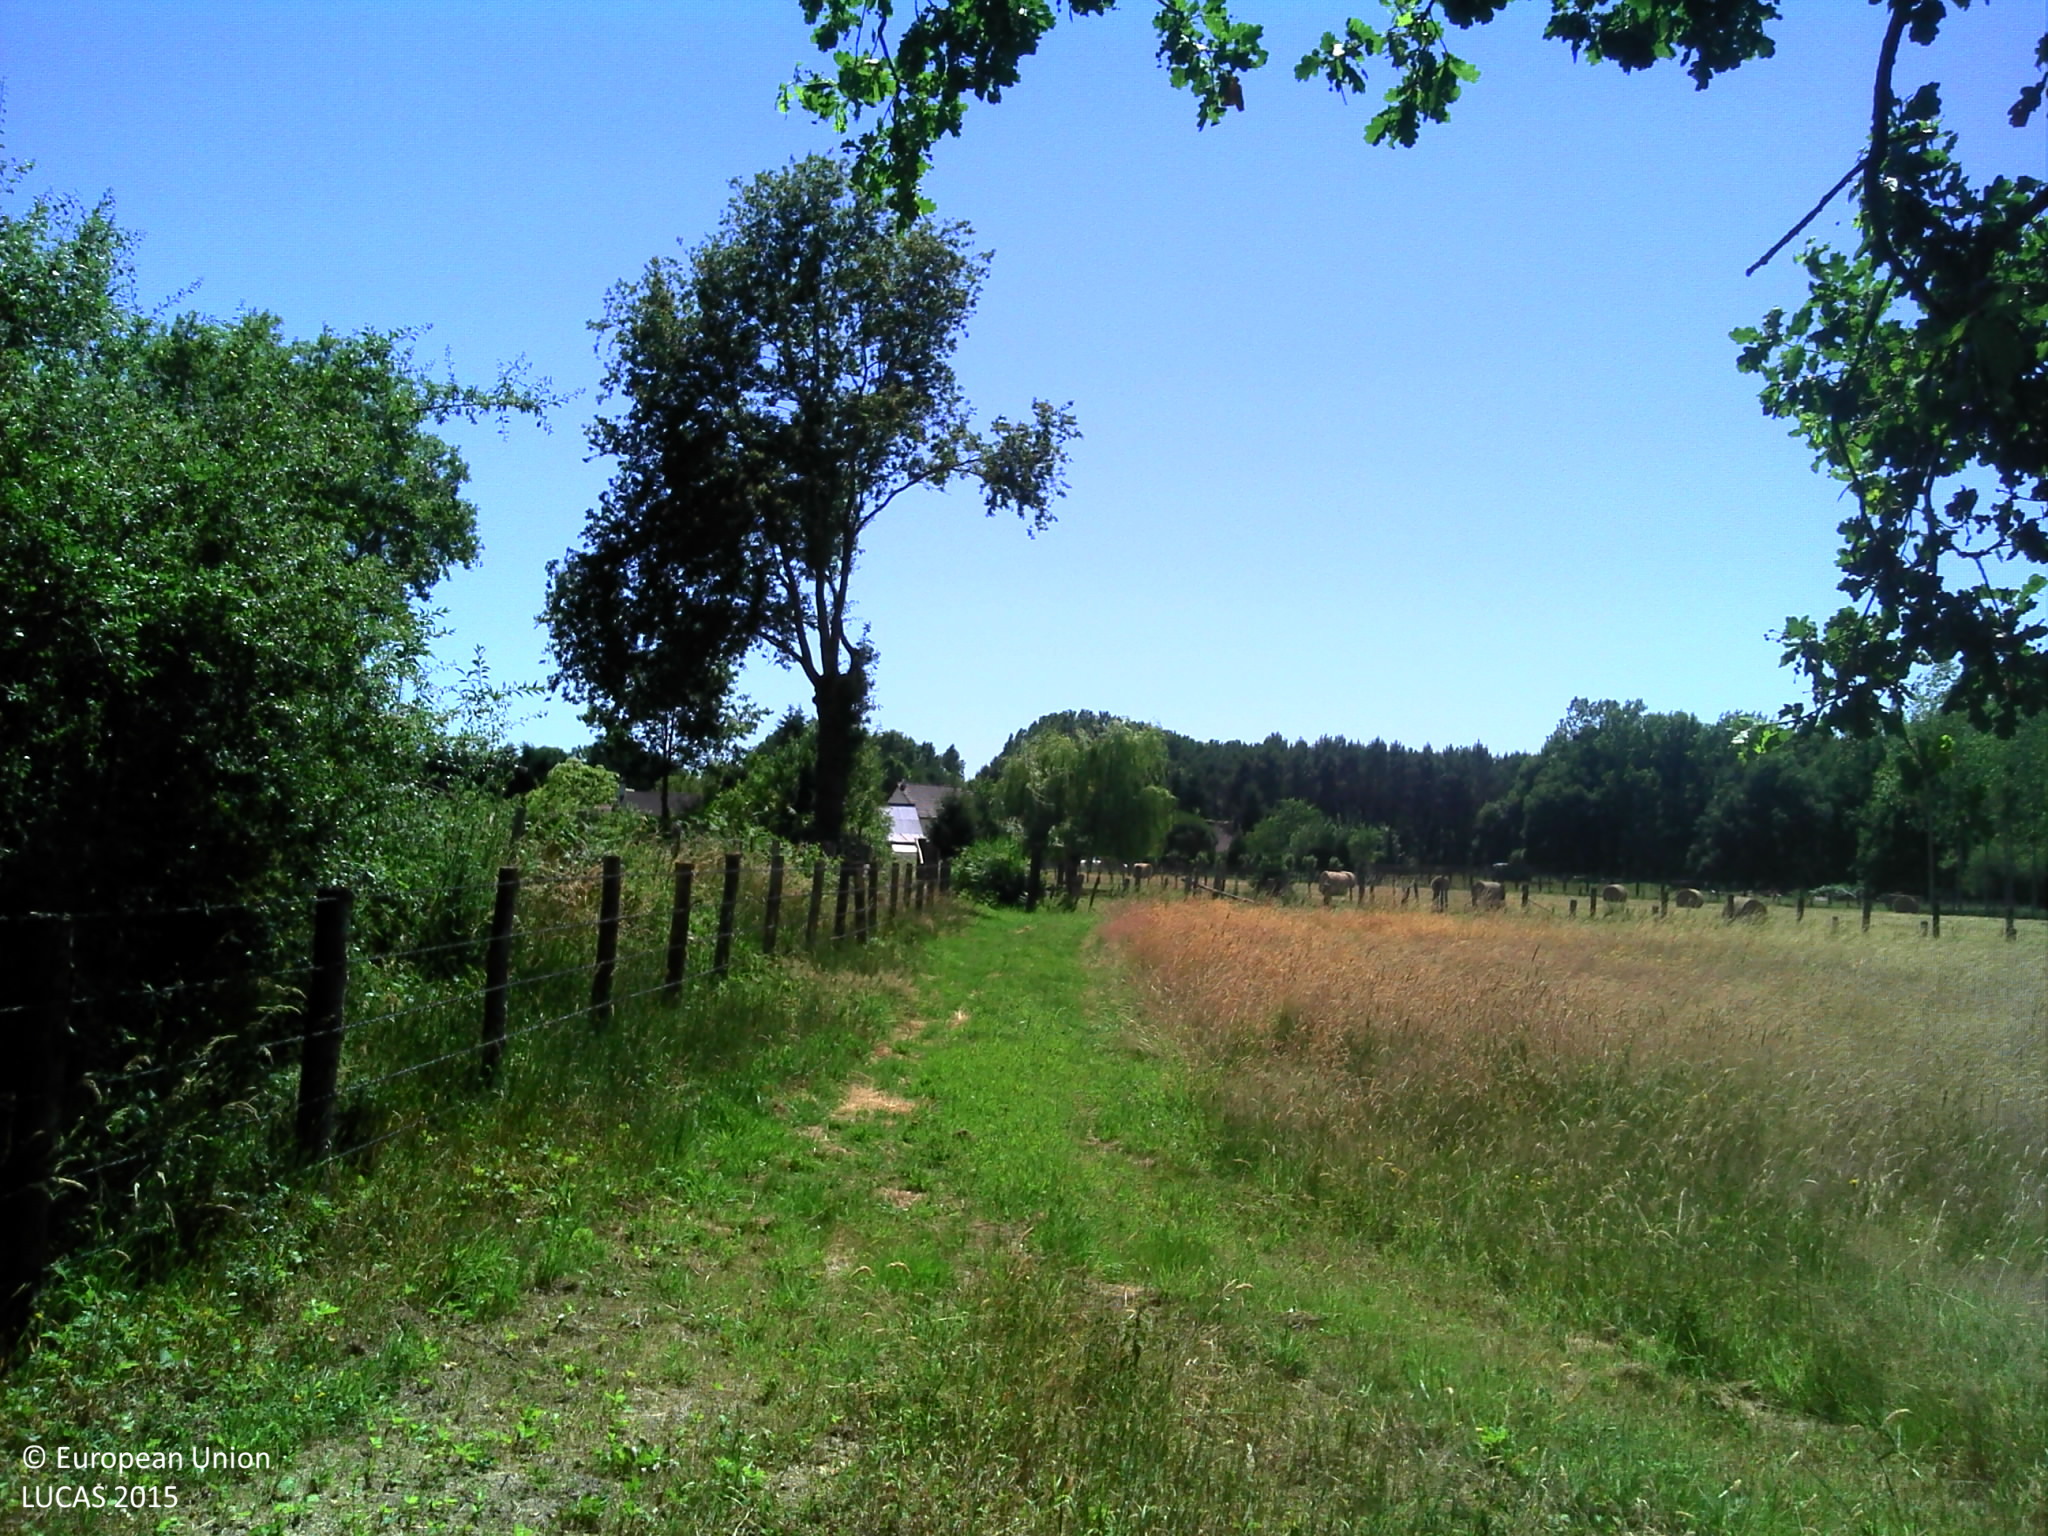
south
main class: Grassland
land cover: Grassland without tree/shrub cover
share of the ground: > 75 %
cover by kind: herbaceous plants 100 %
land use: Agriculture (excluding fallow land and kitchen gardens)
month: June
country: FR
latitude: 47.9573
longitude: 0.2929
